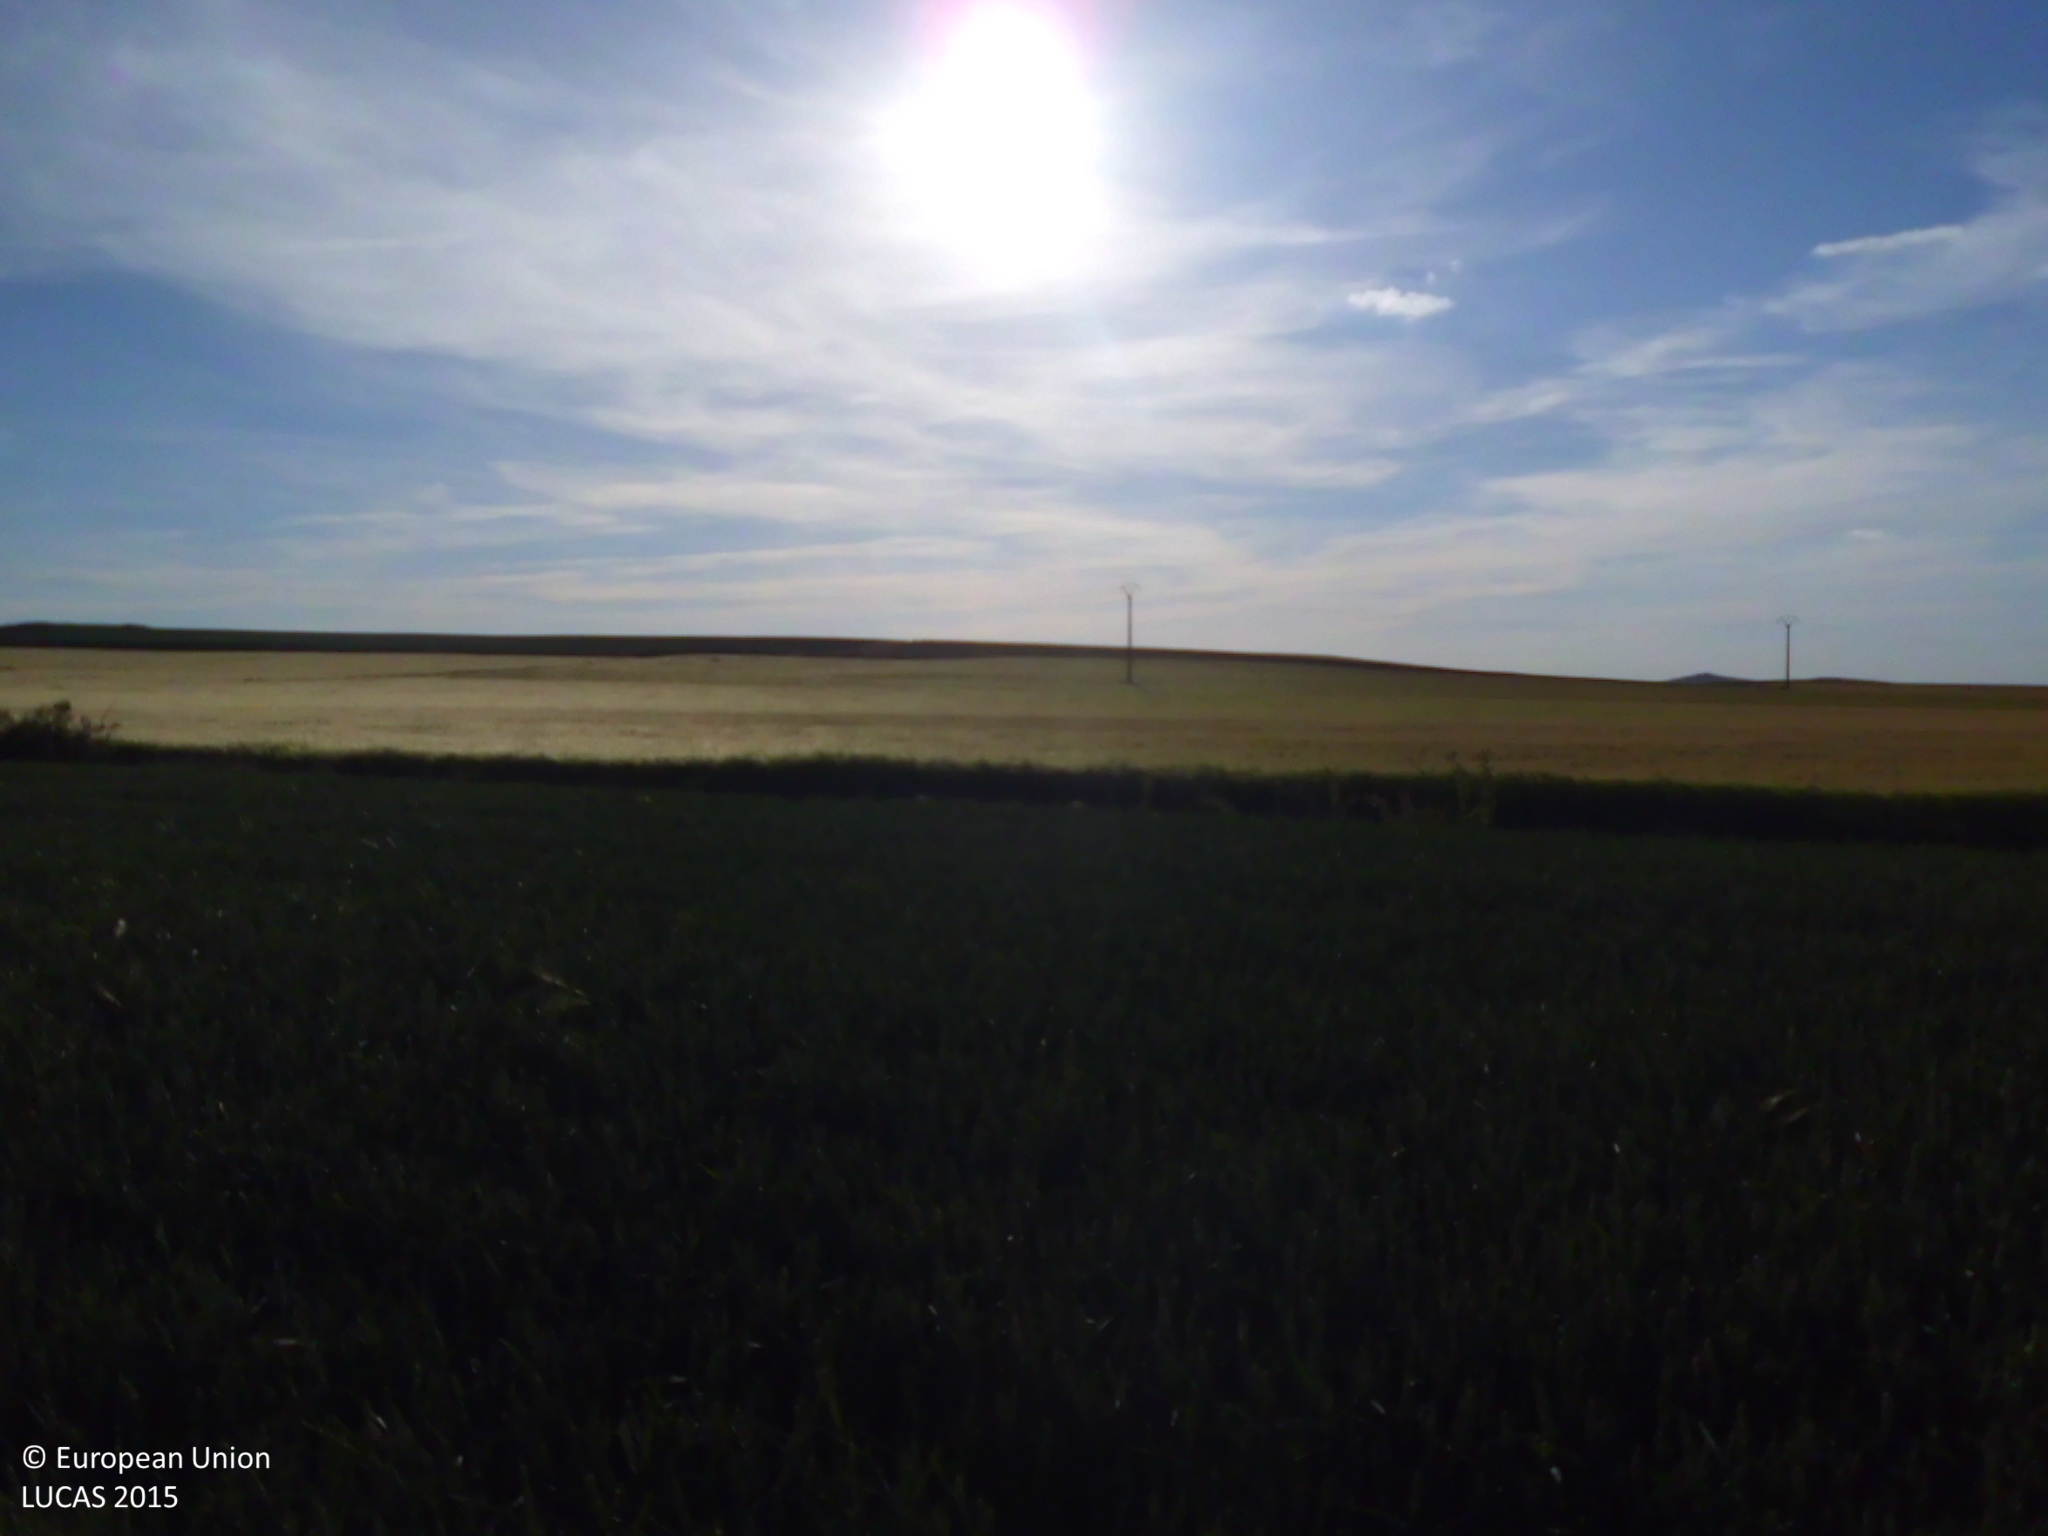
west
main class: Cropland
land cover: Common wheat
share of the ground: > 75 %
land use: Agriculture (excluding fallow land and kitchen gardens)
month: May
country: ES
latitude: 42.3101
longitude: -4.1771
